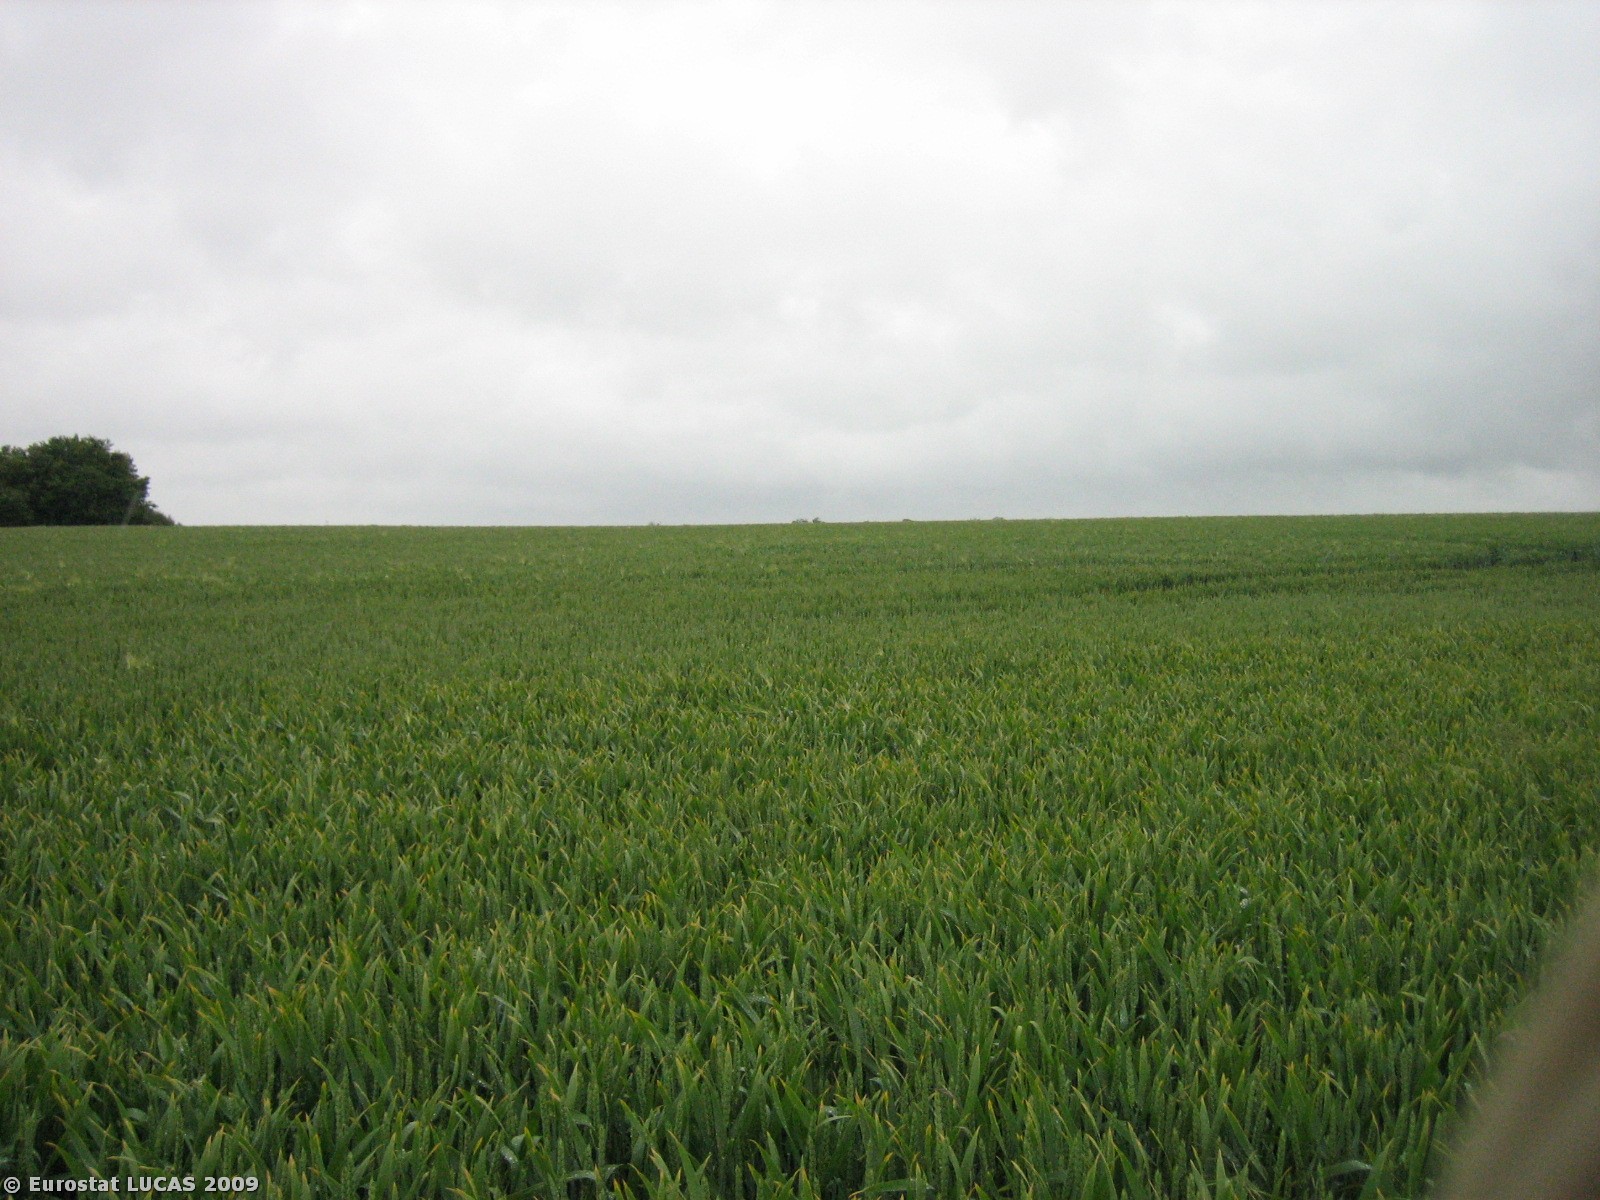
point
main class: Cropland
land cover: Common wheat
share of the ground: > 75 %
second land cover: Barley
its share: < 10 %
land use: Agriculture (excluding fallow land and kitchen gardens)
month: June
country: DK
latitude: 56.0260
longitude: 9.9840
